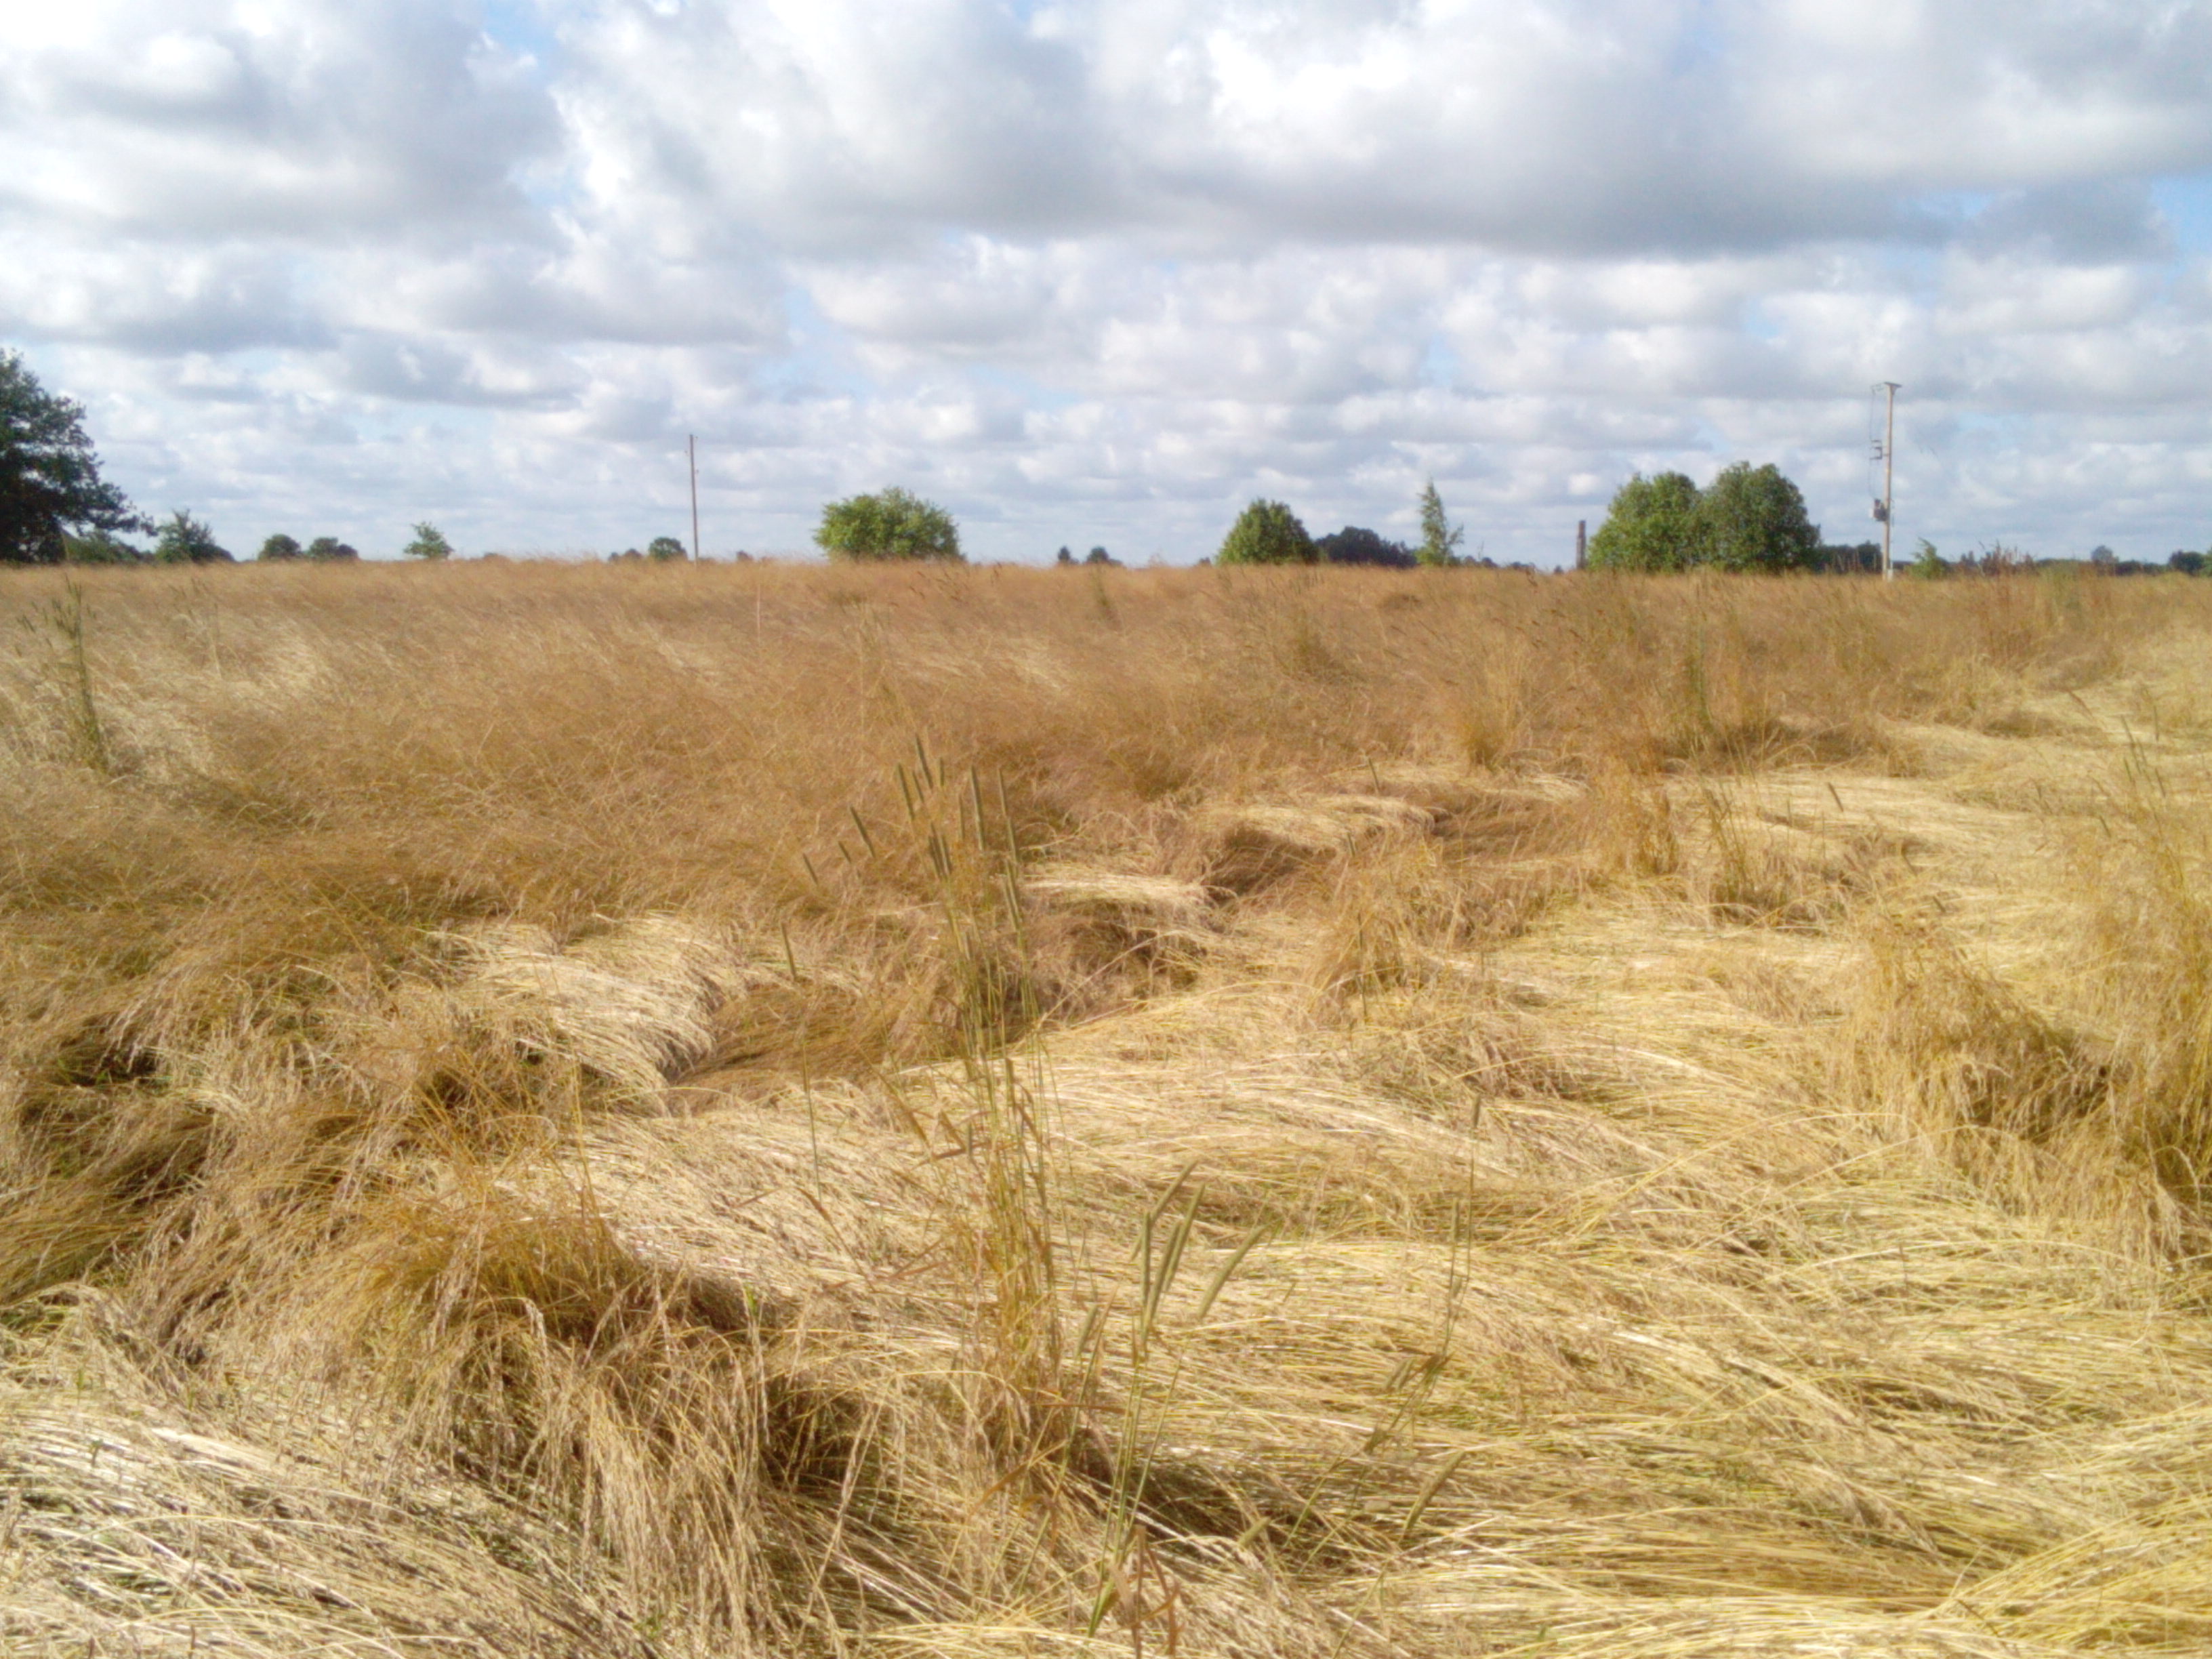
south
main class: Grassland
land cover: Grassland without tree/shrub cover
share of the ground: > 75 %
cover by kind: herbaceous plants 95 %, shrubs 5 %
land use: Agriculture (excluding fallow land and kitchen gardens)
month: July
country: LV
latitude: 56.6848
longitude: 21.3196
